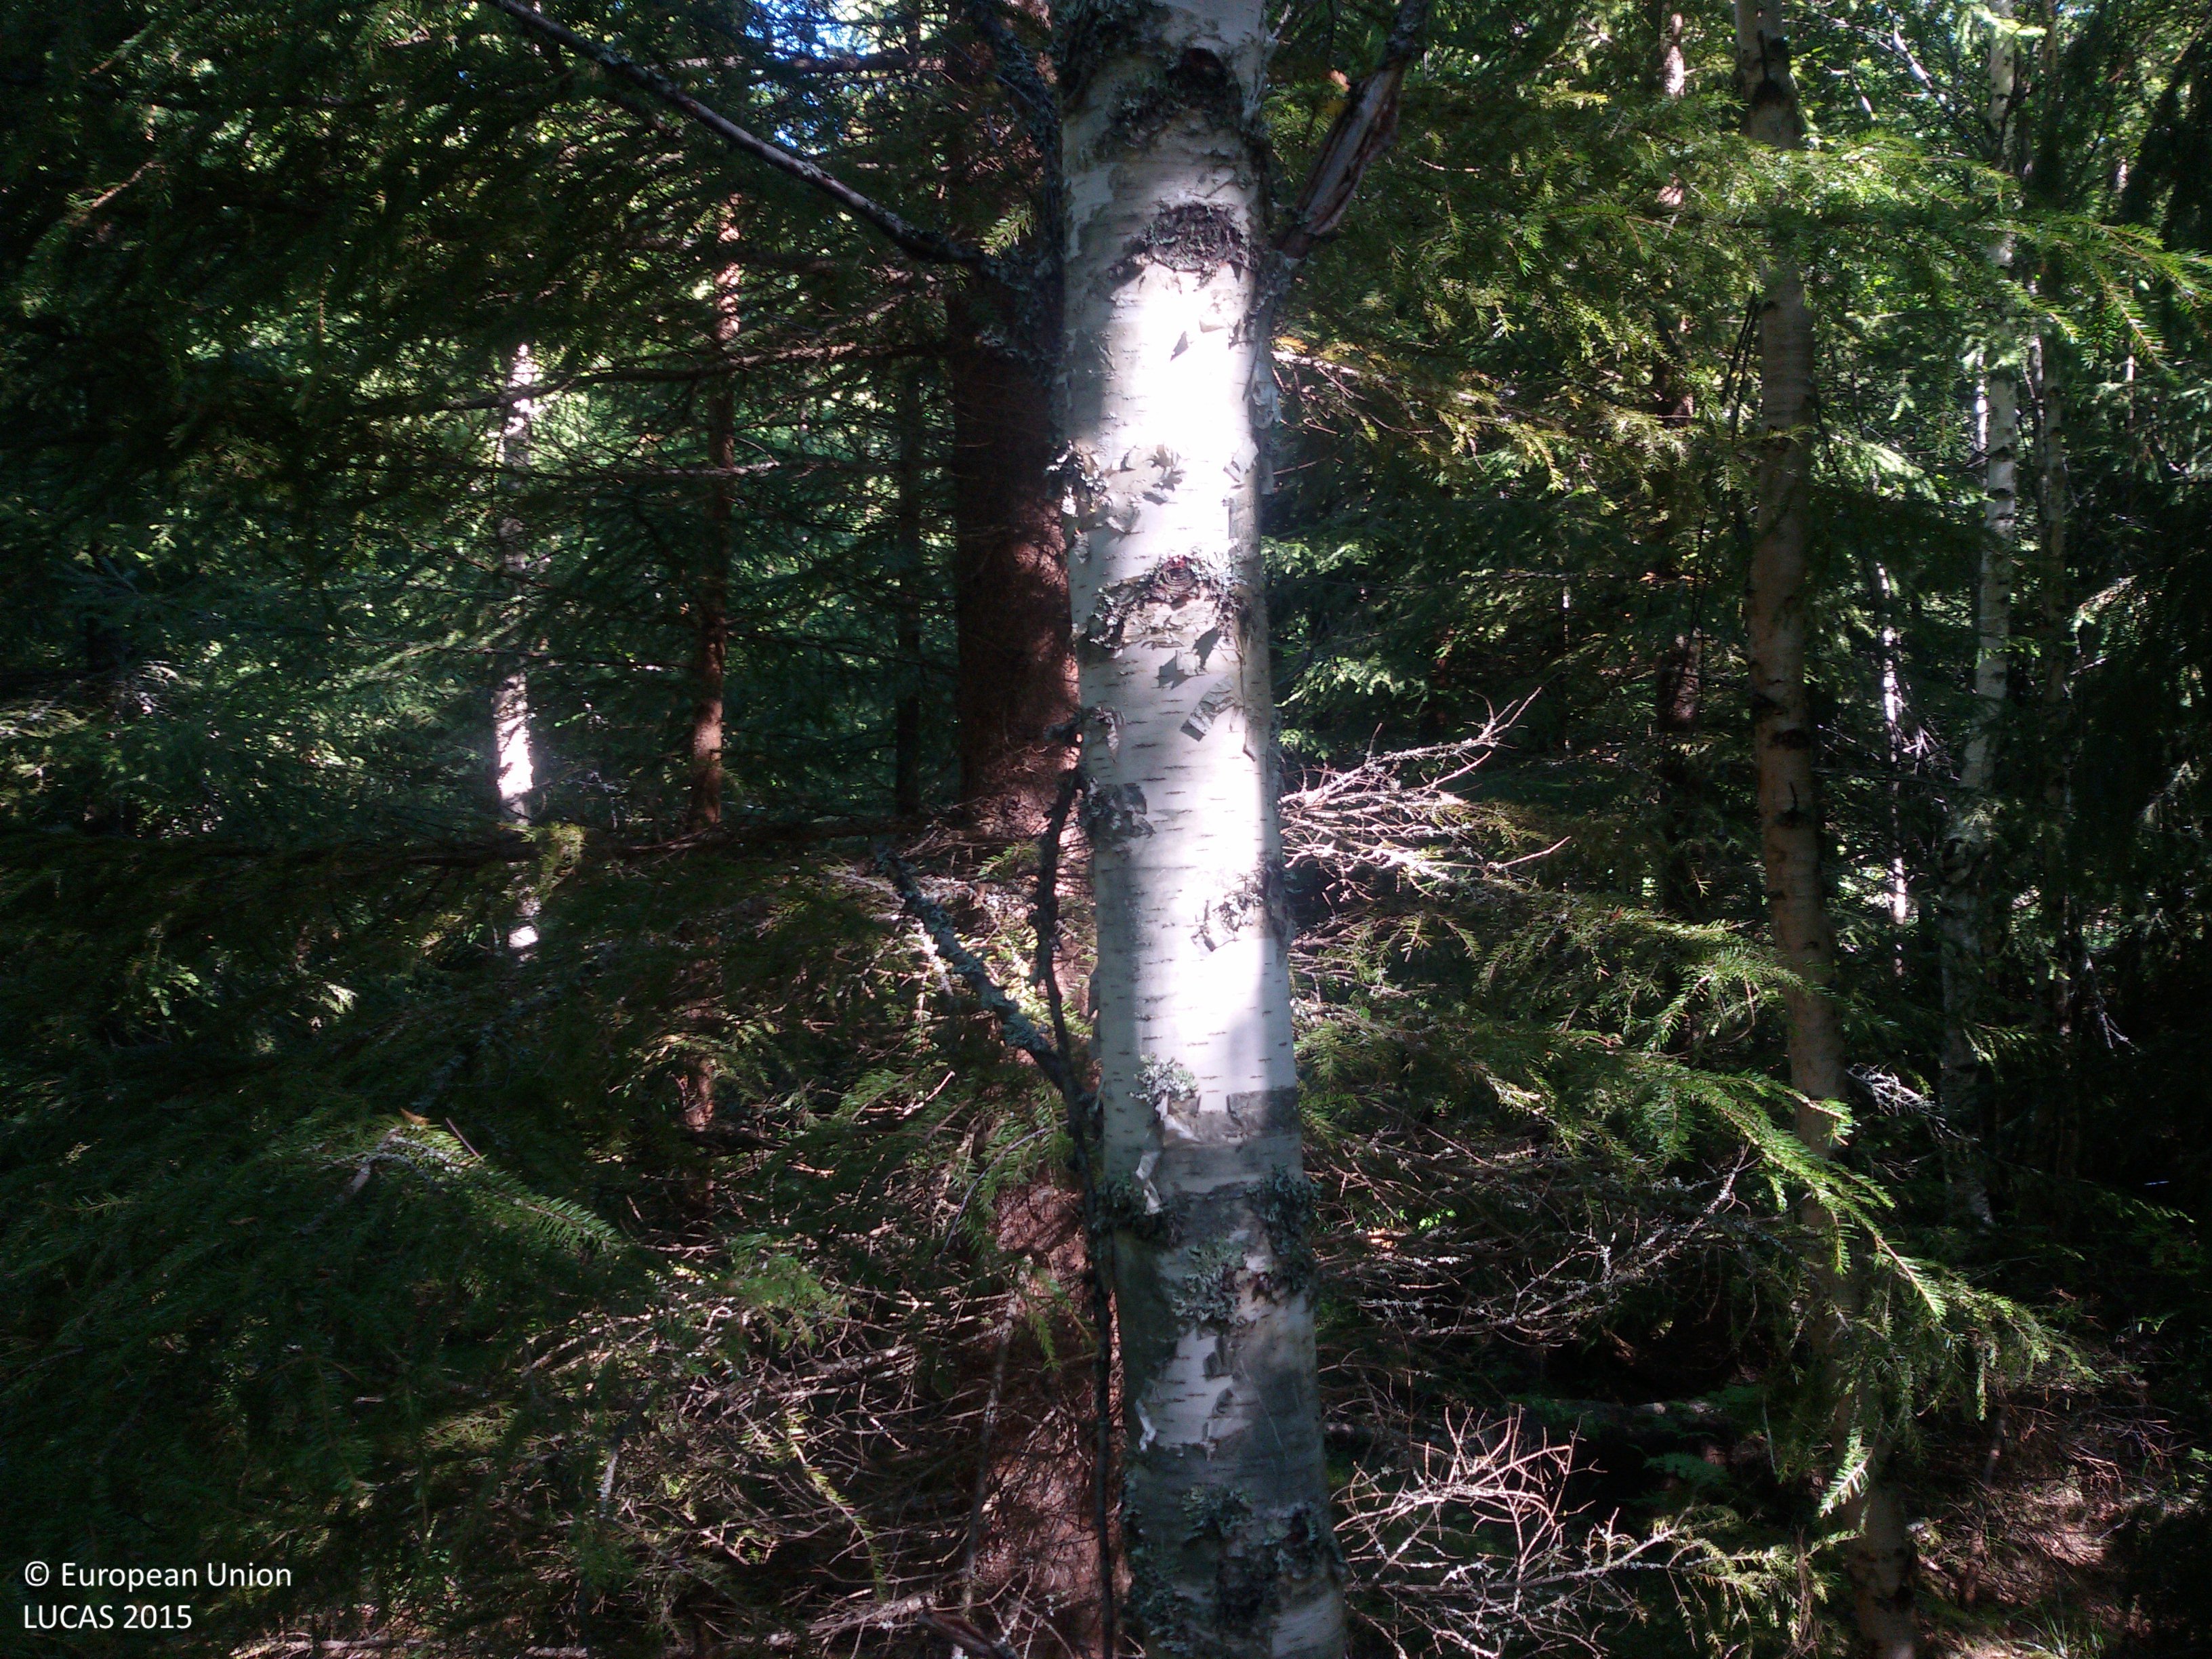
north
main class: Woodland
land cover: Spruce dominated mixed woodland
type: boreal forest
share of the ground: > 75 %
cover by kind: coniferous forest trees 50 %, broadleaved forest trees 30 %, shrubs 10 %, lichens and mosses 10 %
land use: Forestry
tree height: > 5 m
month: August
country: SE
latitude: 60.7016
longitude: 16.4543
